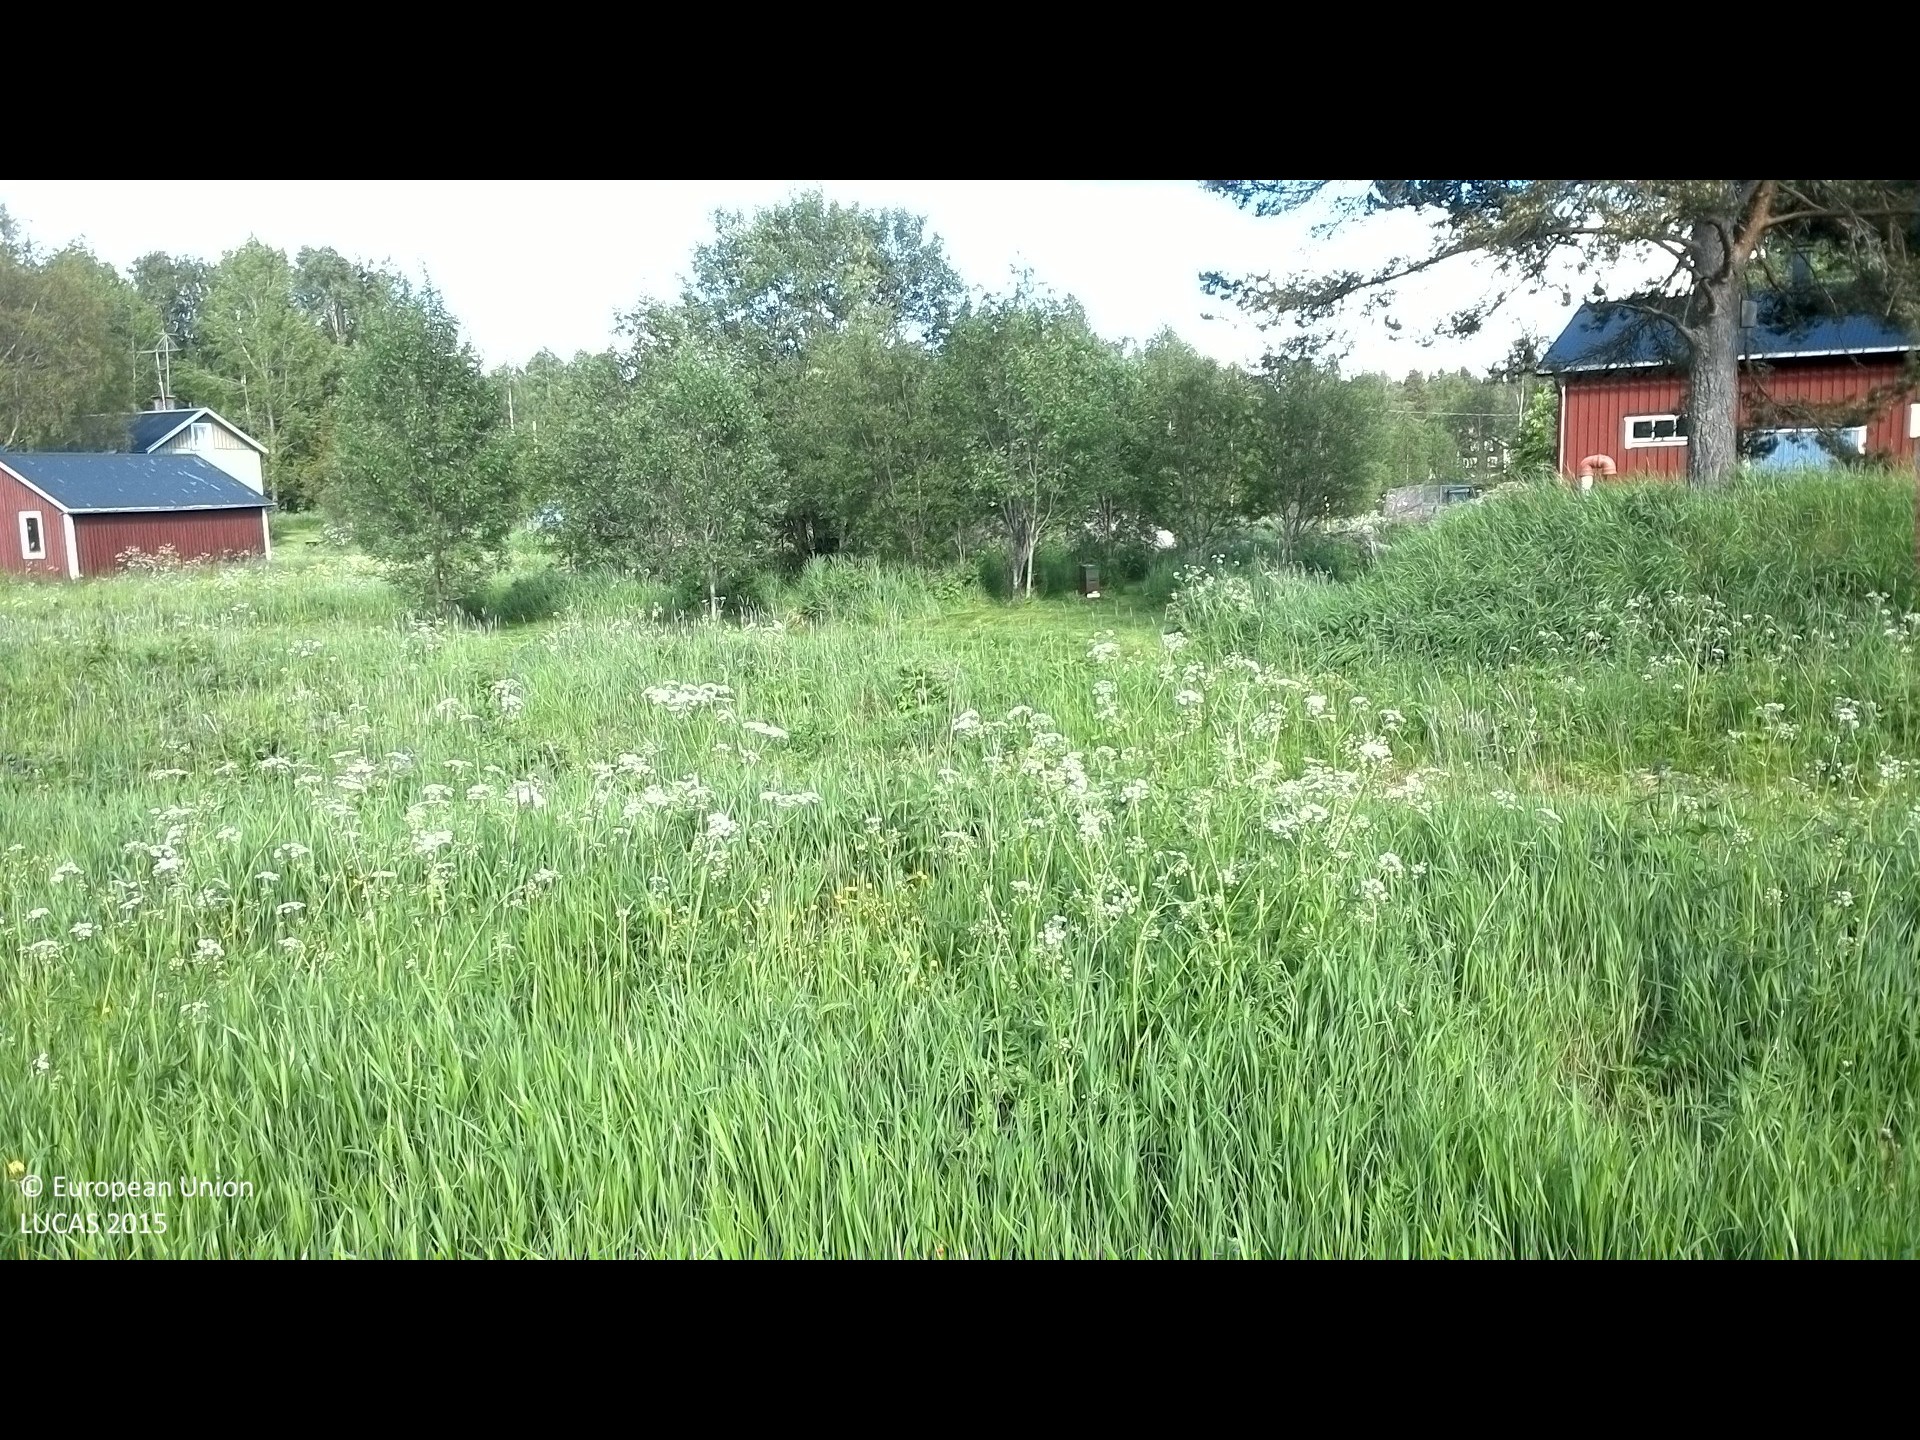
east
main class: Cropland
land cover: Other leguminous and mixtures for fodder
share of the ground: > 75 %
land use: Agriculture (excluding fallow land and kitchen gardens)
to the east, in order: Other leguminous and mixtures for fodder; Ditches and canals; Paved roads, cycling and walking lanes; Ditches and canals; Grass margins; Artificial constructions in urban areas; Grass margins; Ditches and canals; Paved roads, cycling and walking lanes; Ditches and canals; Grass margins; Ditches and canals; Broadleaved woodland; Electric lines; Broadleaved woodland; Grass margins; Ditches and canals; Paved roads, cycling and walking lanes; Grass margins; Ditches and canals; Grass margins; Other leguminous and mixtures for fodder; Broadleaved woodland; Other leguminous and mixtures for fodder
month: June
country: SE
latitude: 61.9310
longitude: 17.2413
